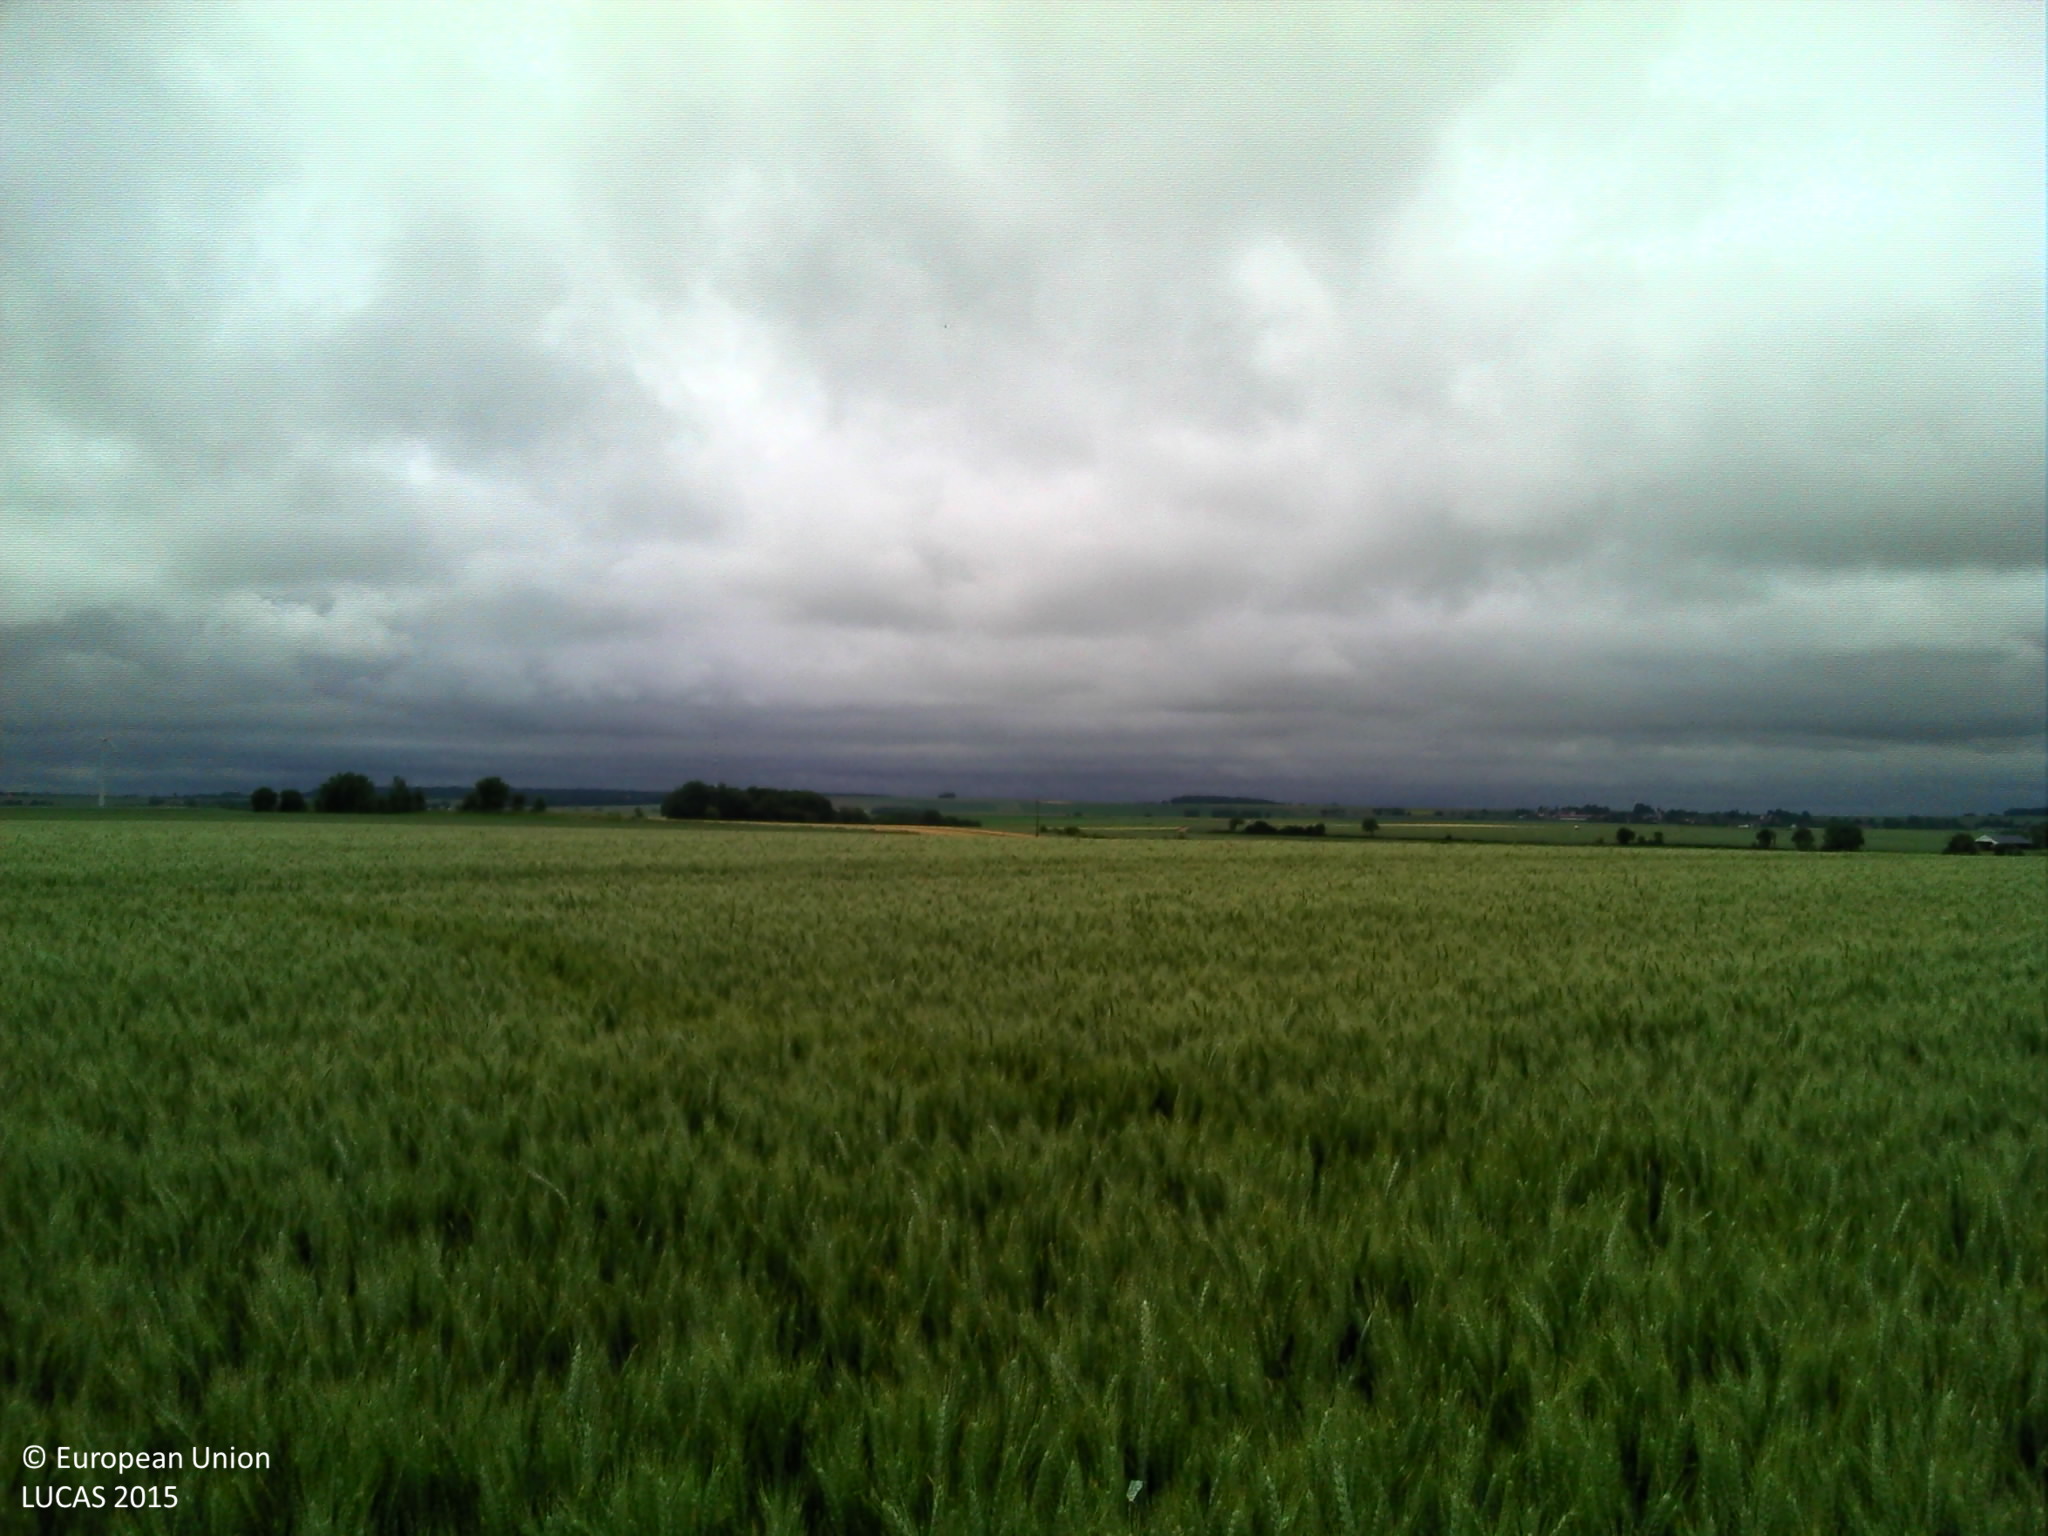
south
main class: Cropland
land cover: Barley
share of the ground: > 75 %
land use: Agriculture (excluding fallow land and kitchen gardens)
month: June
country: FR
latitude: 49.5510
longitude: 2.3989
